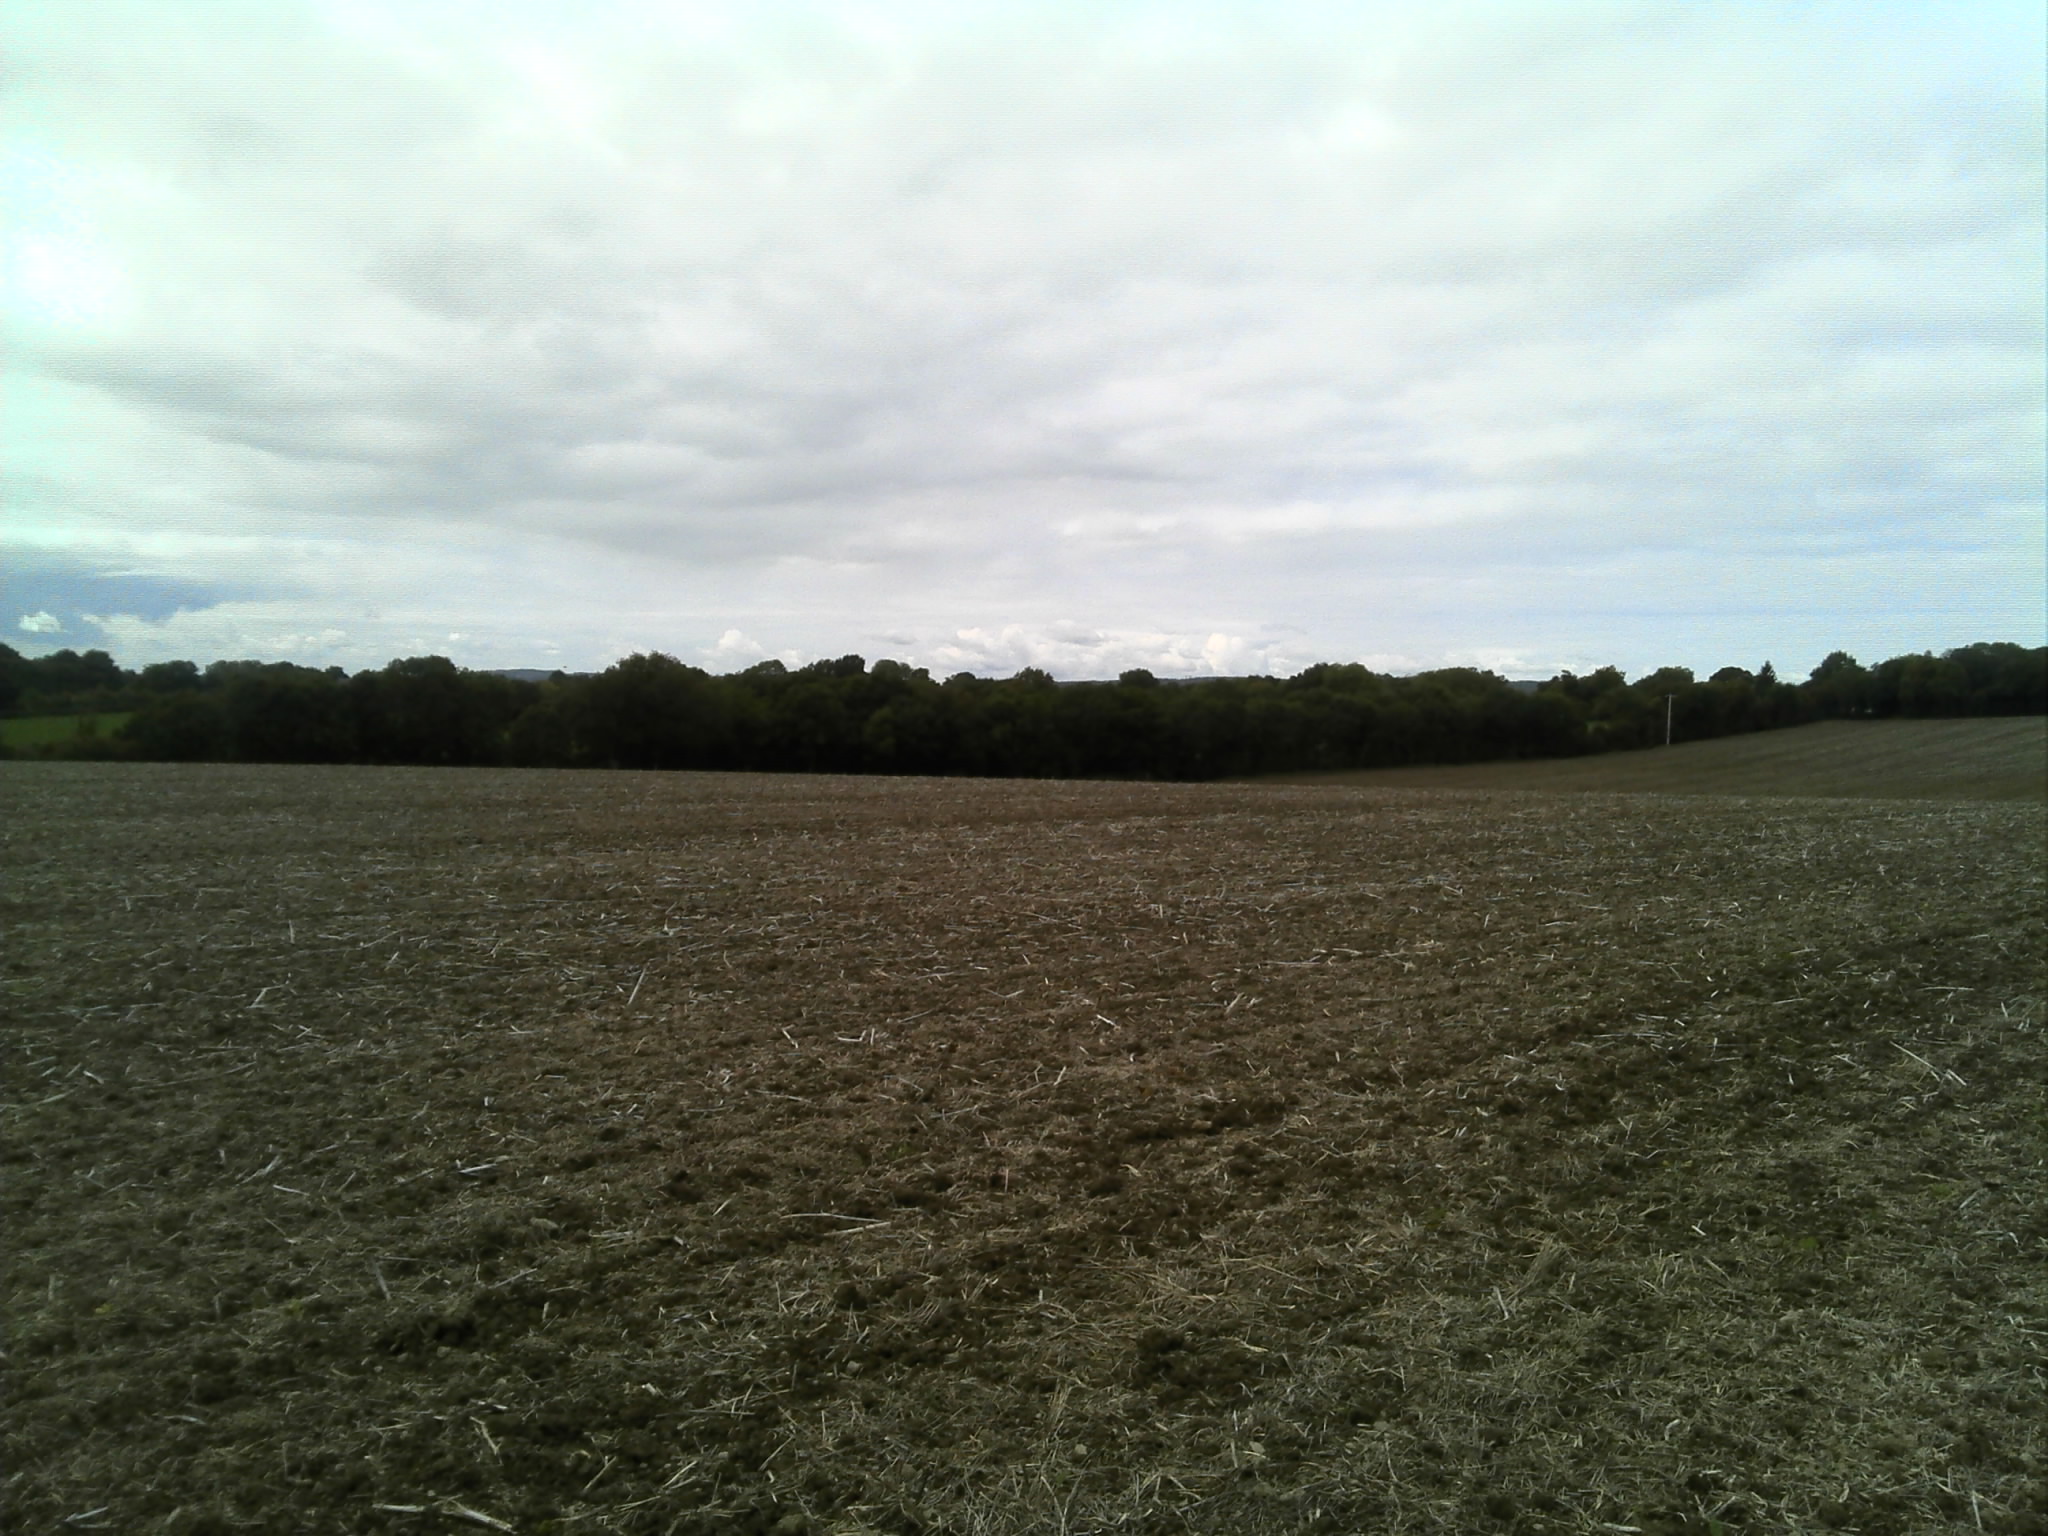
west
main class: Cropland
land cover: Rape and turnip rape
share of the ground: < 10 %
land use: Agriculture (excluding fallow land and kitchen gardens)
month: October
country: FR
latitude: 48.1551
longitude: -0.1253
